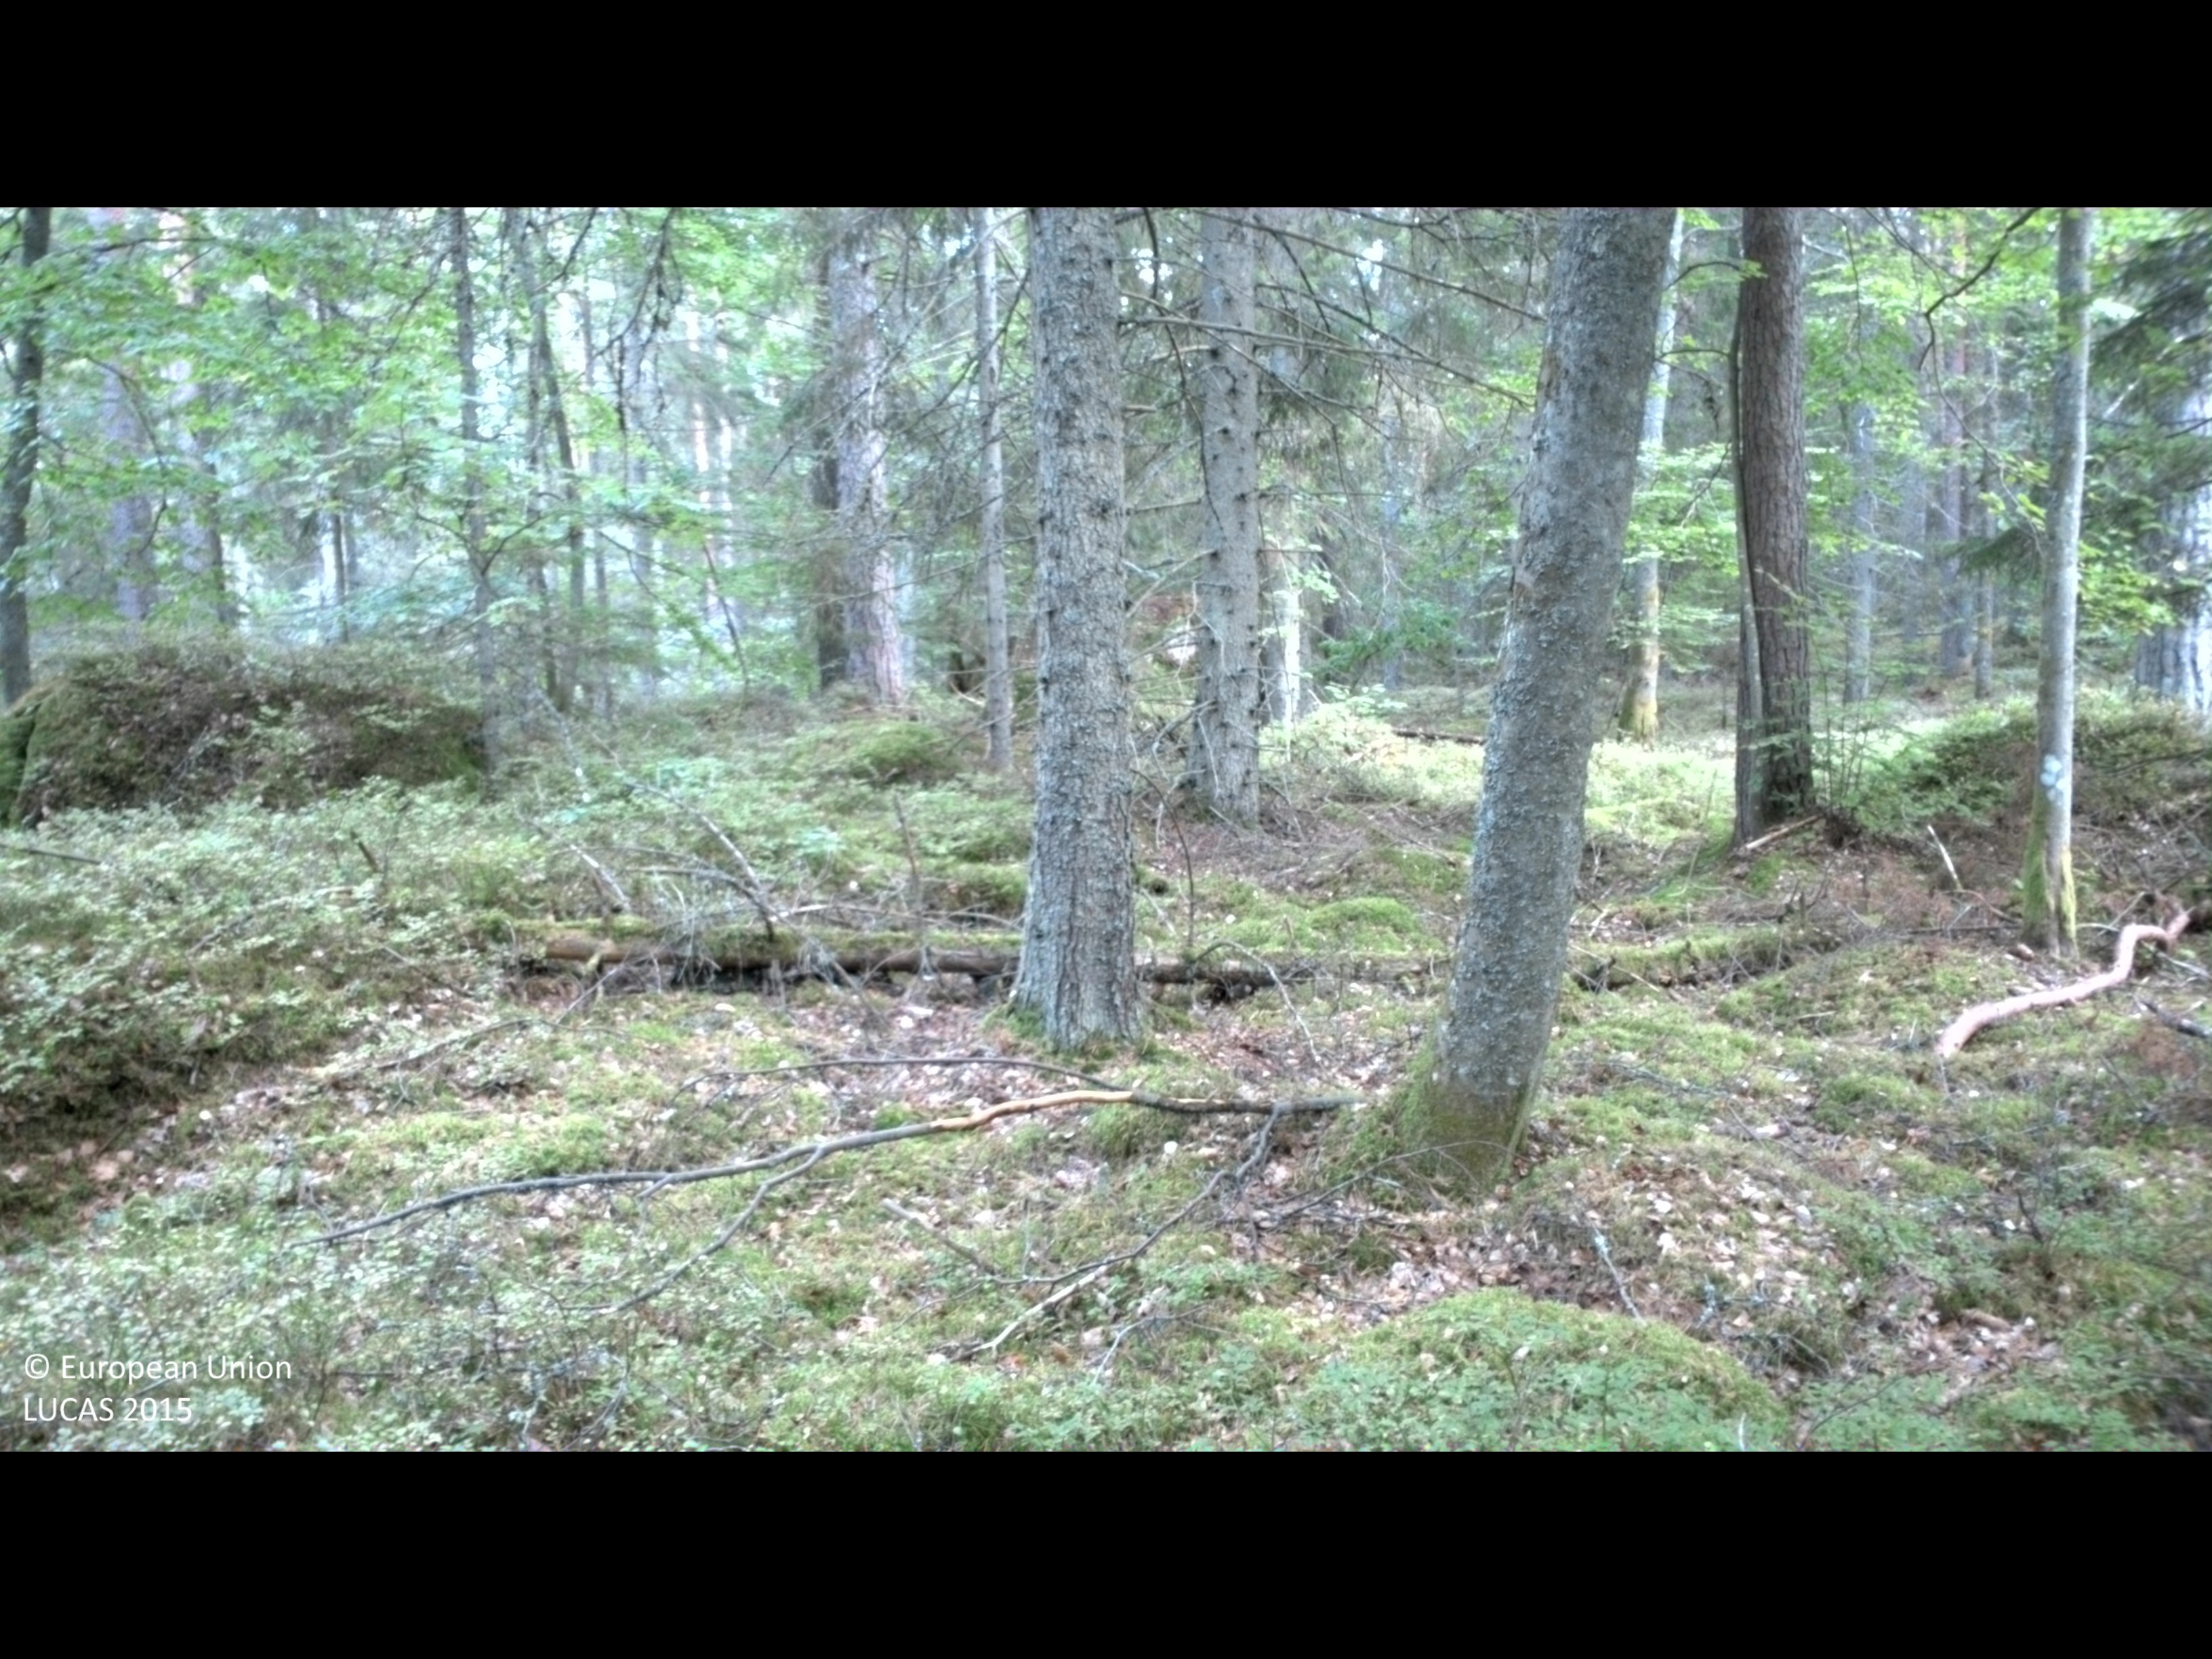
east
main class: Woodland
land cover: Pine dominated mixed woodland
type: hemiboreal forest and nemoral coniferous forest and mixed broadleaved-coniferous forest
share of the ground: 50 - 75 %
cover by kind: coniferous forest trees 50 %, broadleaved forest trees 20 %, shrubs 20 %, lichens and mosses 10 %
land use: Forestry
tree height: > 5 m
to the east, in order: Pine dominated mixed woodland; Tracks; Pine dominated mixed woodland; Spruce dominated coniferous woodland; Tracks; Spruce dominated coniferous woodland; Broadleaved woodland
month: September
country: SE
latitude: 56.2877
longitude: 15.0228
